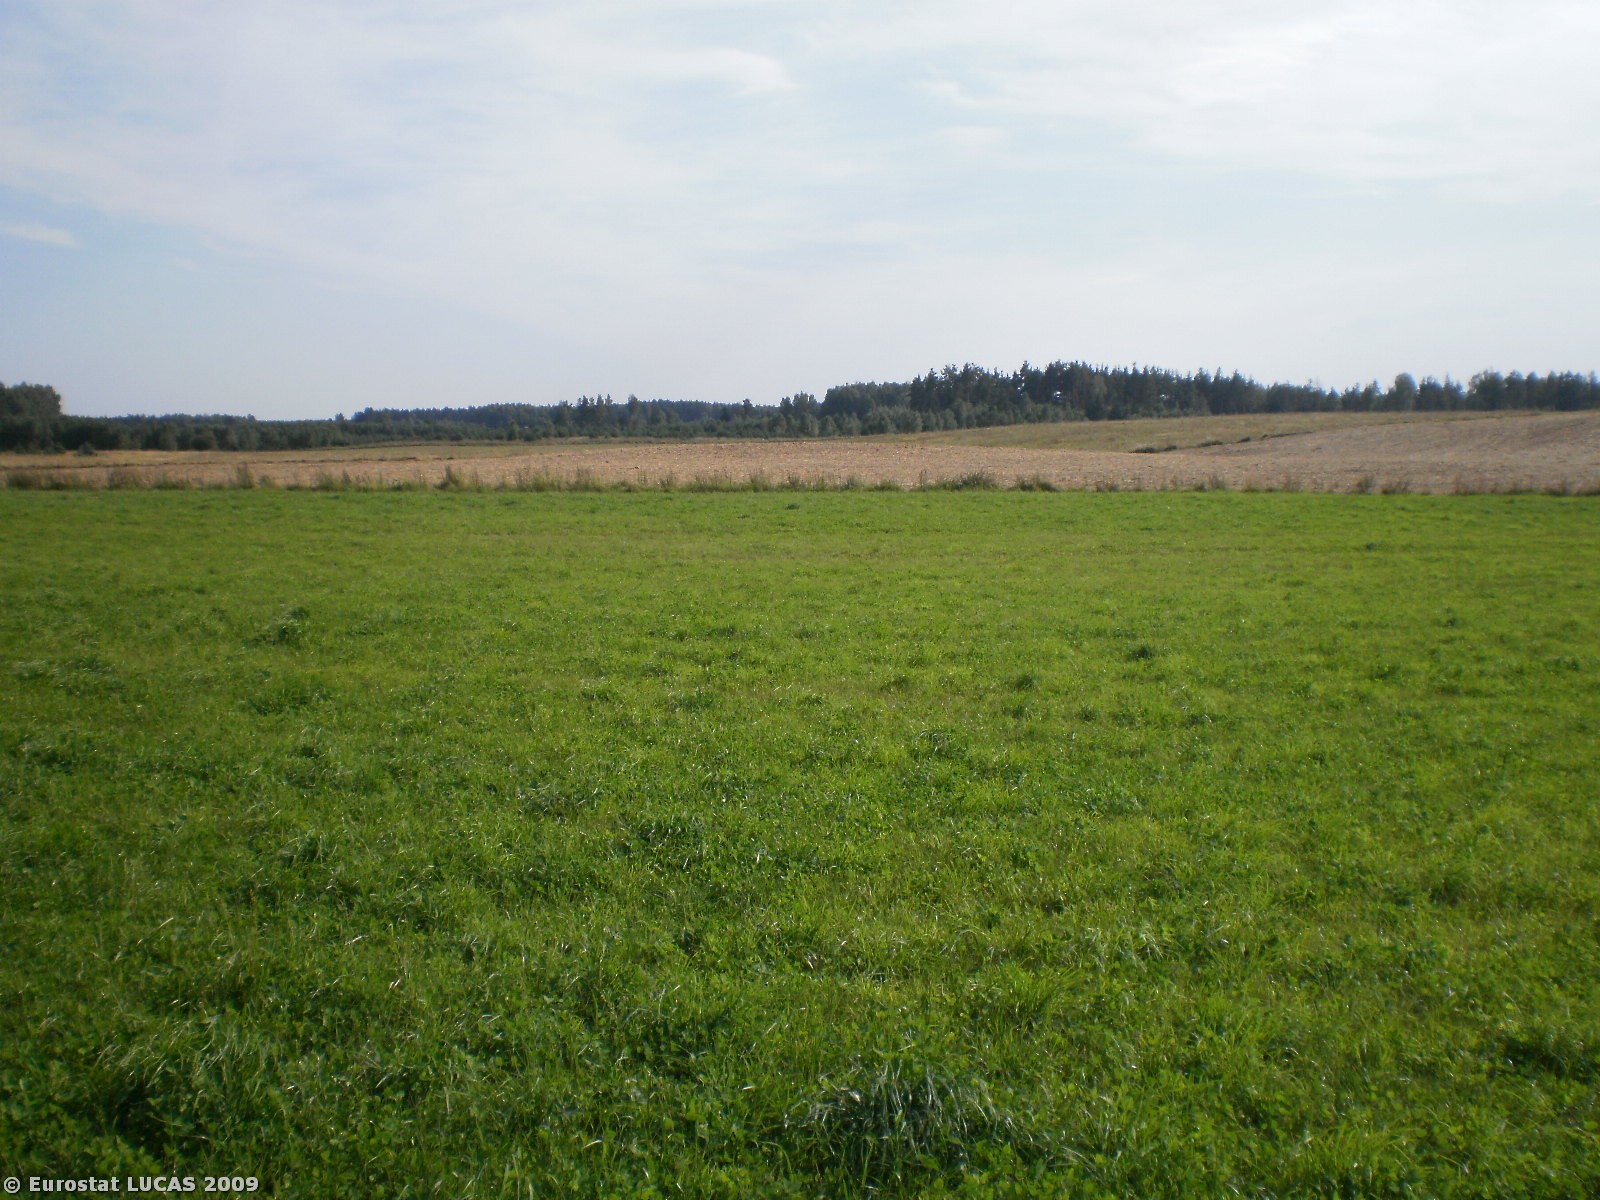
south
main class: Grassland
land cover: Grassland without tree/shrub cover
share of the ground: > 75 %
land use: Agriculture (excluding fallow land and kitchen gardens)
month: September
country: PL
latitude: 53.6725
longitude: 21.0790
